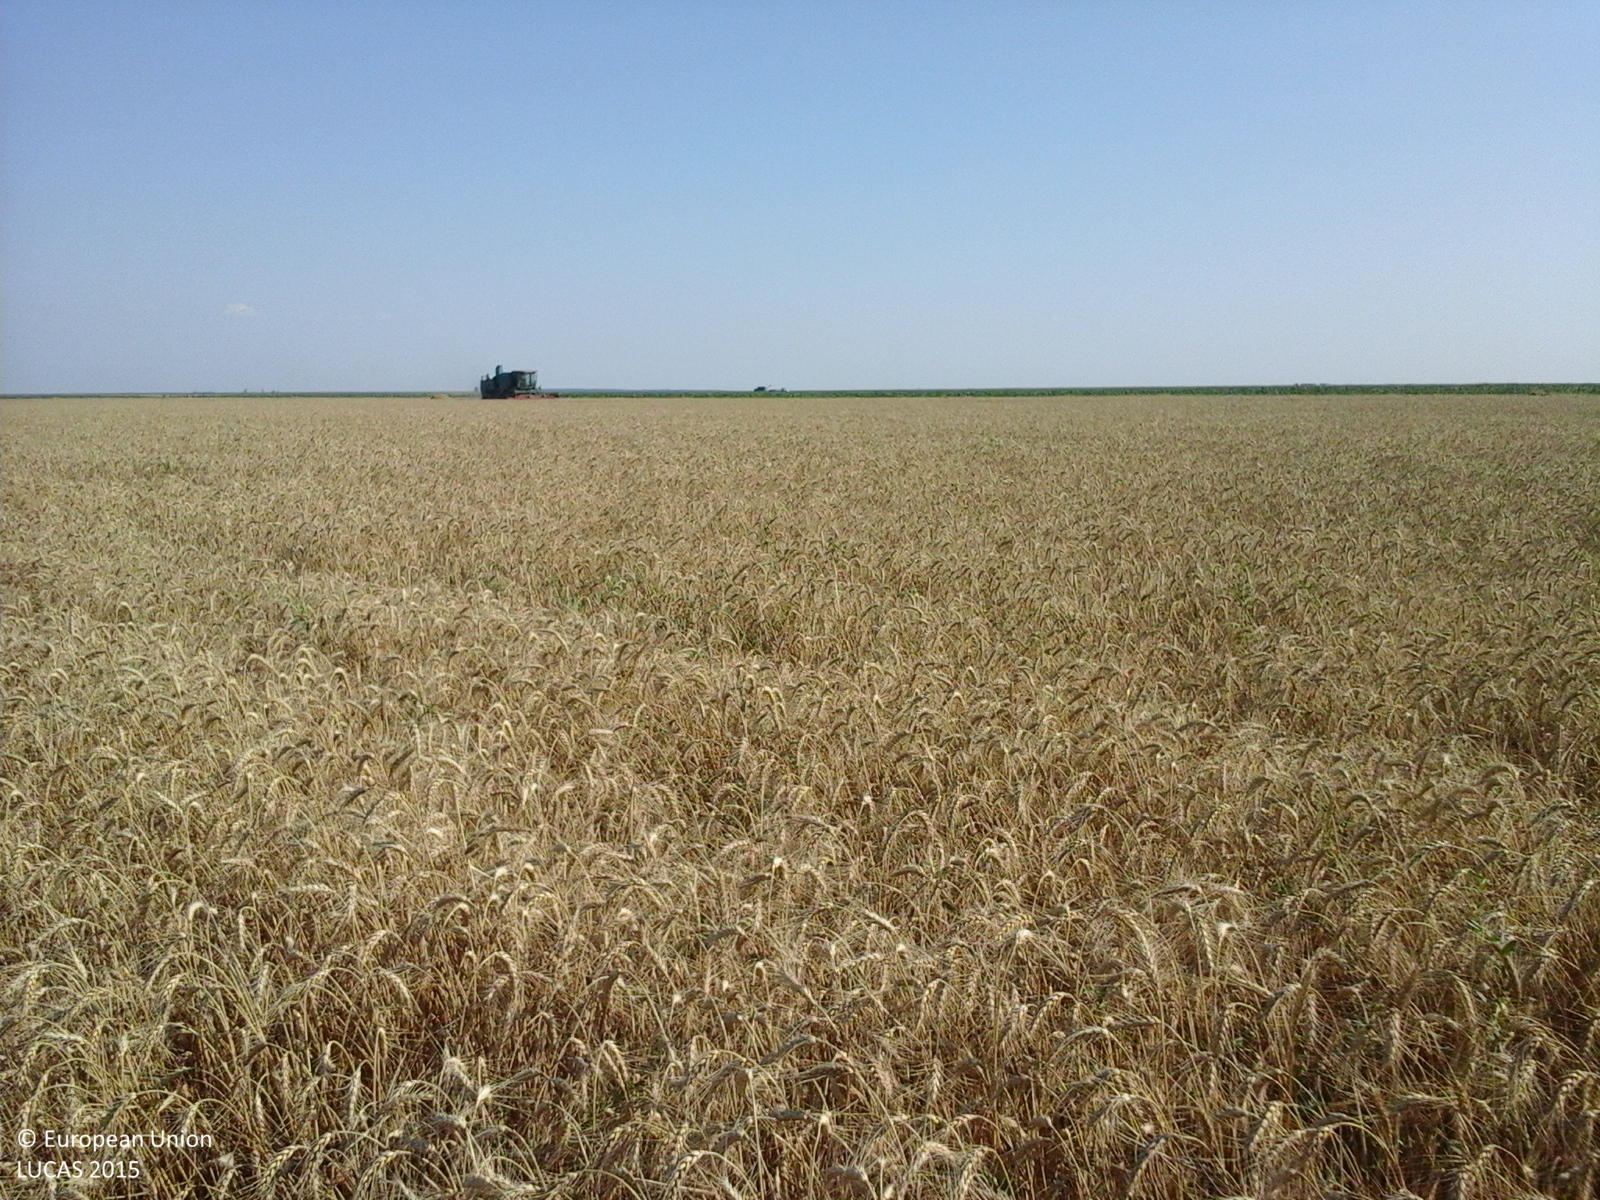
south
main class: Cropland
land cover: Common wheat
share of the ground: > 75 %
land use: Agriculture (excluding fallow land and kitchen gardens)
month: July
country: RO
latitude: 44.2895
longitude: 24.6722
